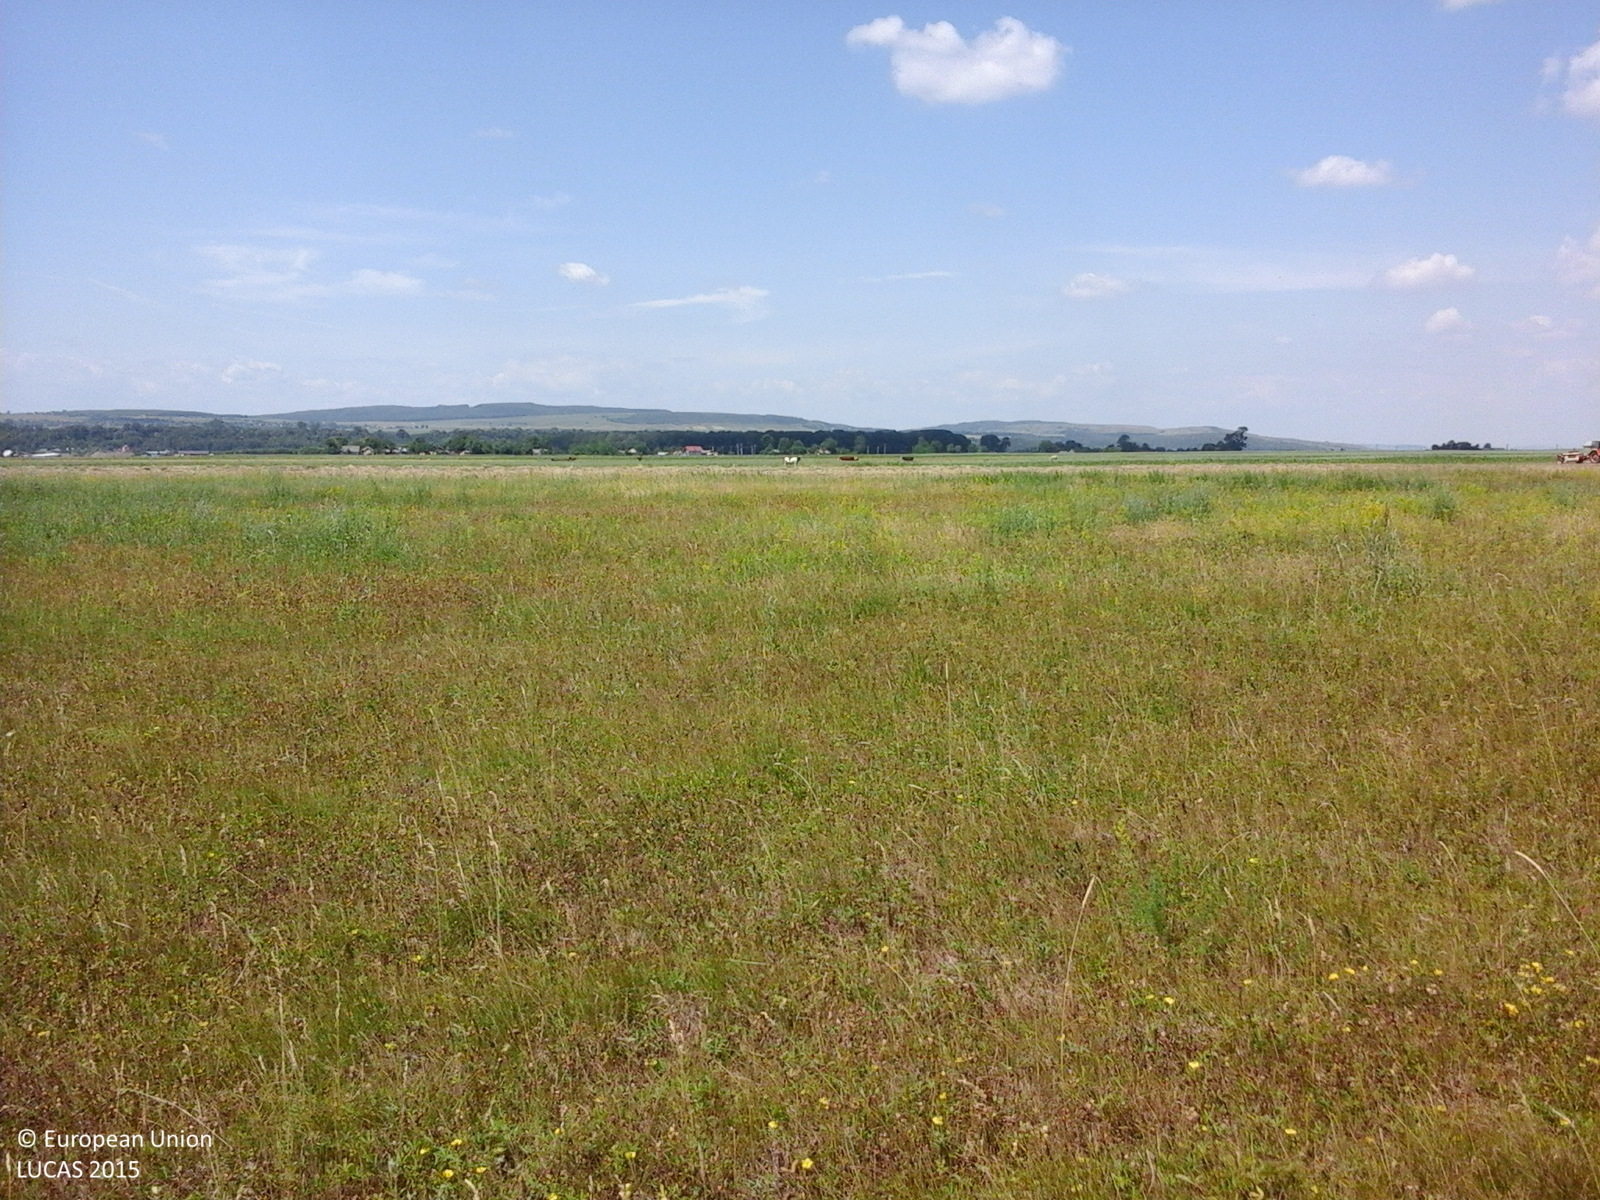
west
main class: Grassland
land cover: Grassland without tree/shrub cover
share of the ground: > 75 %
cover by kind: herbaceous plants 100 %
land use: Agriculture (excluding fallow land and kitchen gardens)
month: June
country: RO
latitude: 47.5482
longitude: 26.5537
